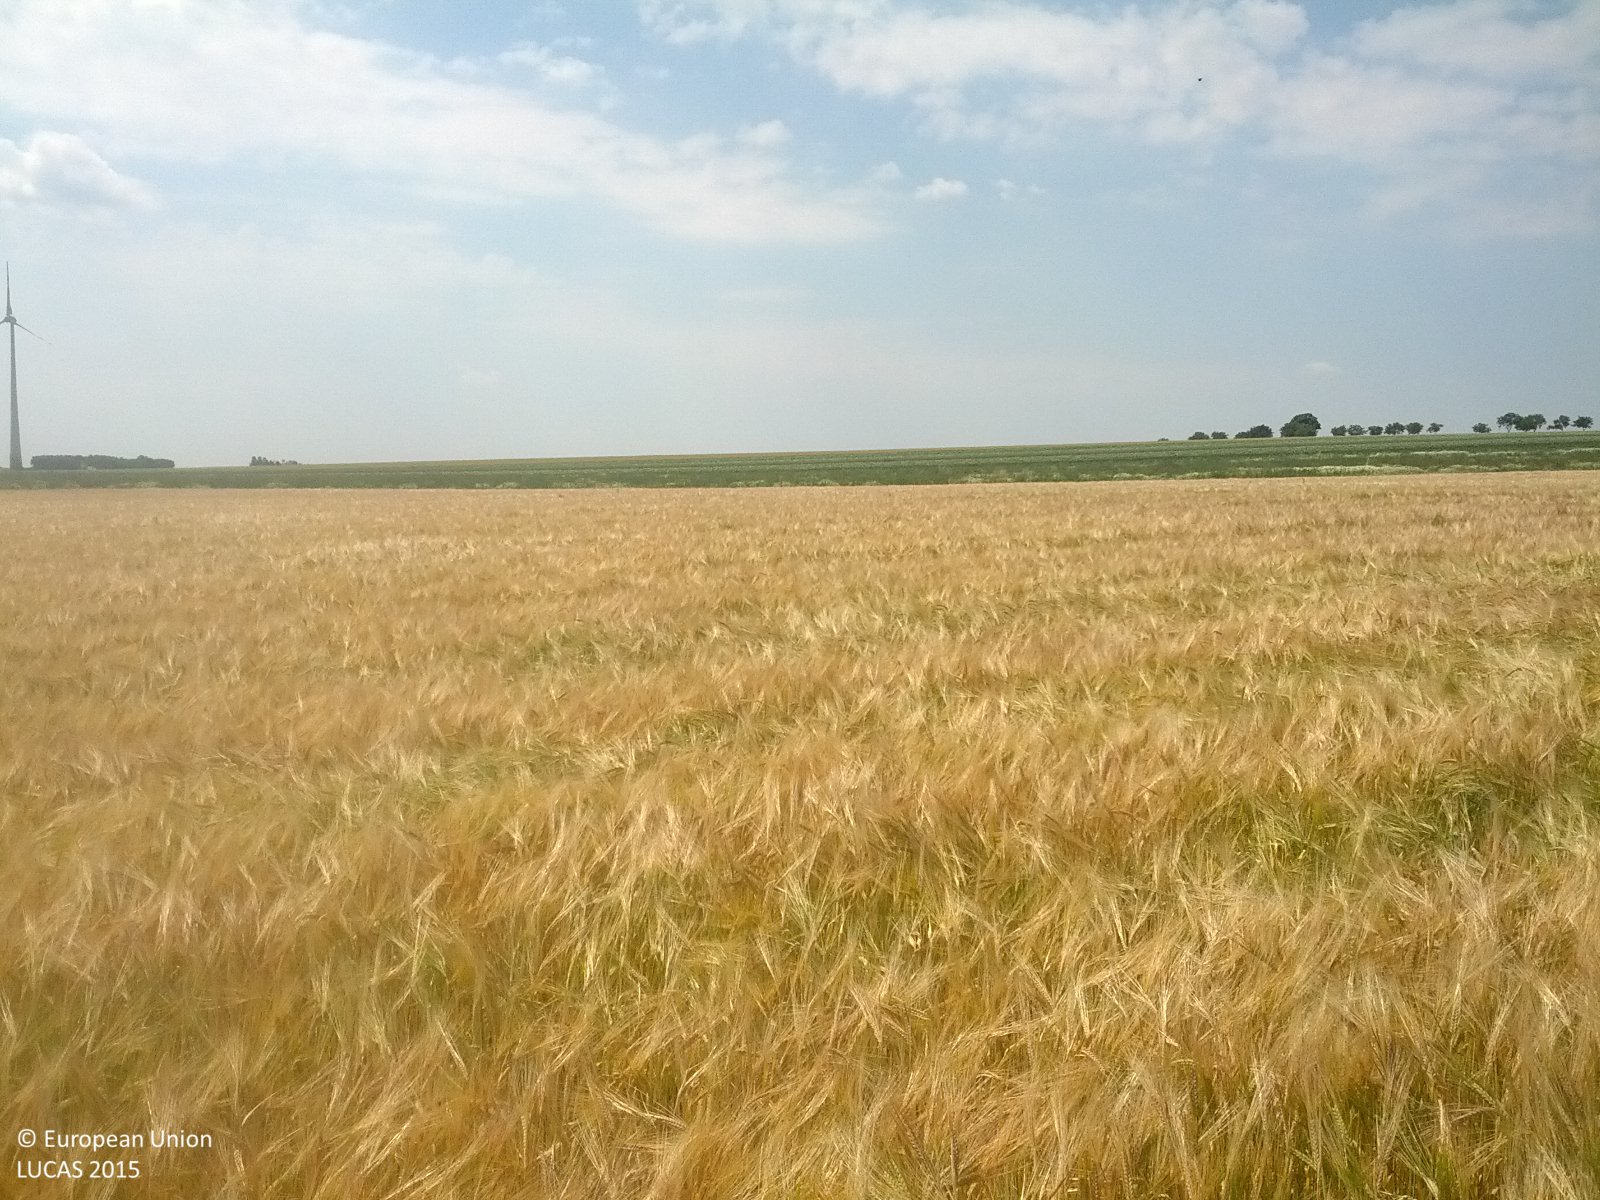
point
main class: Cropland
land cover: Barley
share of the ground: > 75 %
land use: Agriculture (excluding fallow land and kitchen gardens)
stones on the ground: < 10 %
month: July
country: AT
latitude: 48.6662
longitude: 16.7557
